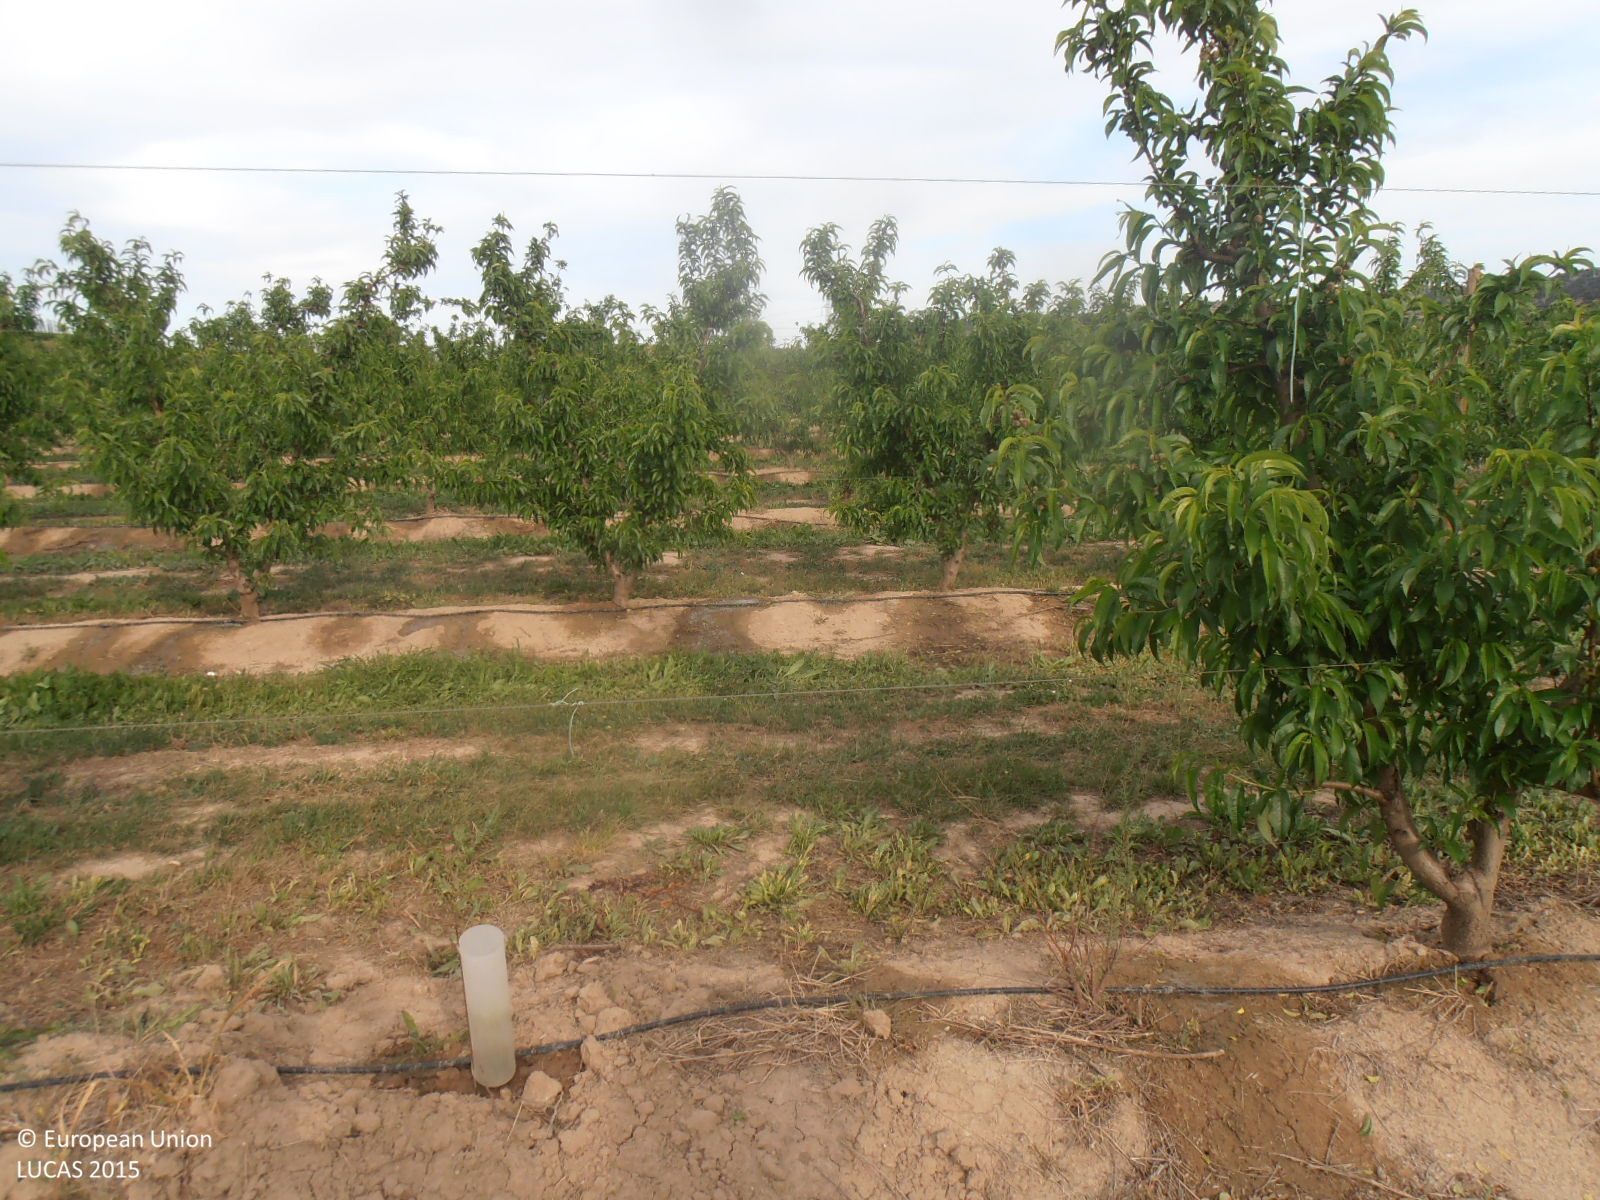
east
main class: Cropland
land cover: Other fruit trees and berries
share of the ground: 50 - 75 %
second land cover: Grassland without tree/shrub cover
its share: > 75 %
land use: Agriculture (excluding fallow land and kitchen gardens)
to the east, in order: Other fruit trees and berries; Grassland without tree/shrub cover; Electric lines; Grass margins; Other fruit trees and berries
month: April
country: ES
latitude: 41.2810
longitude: -0.3903
